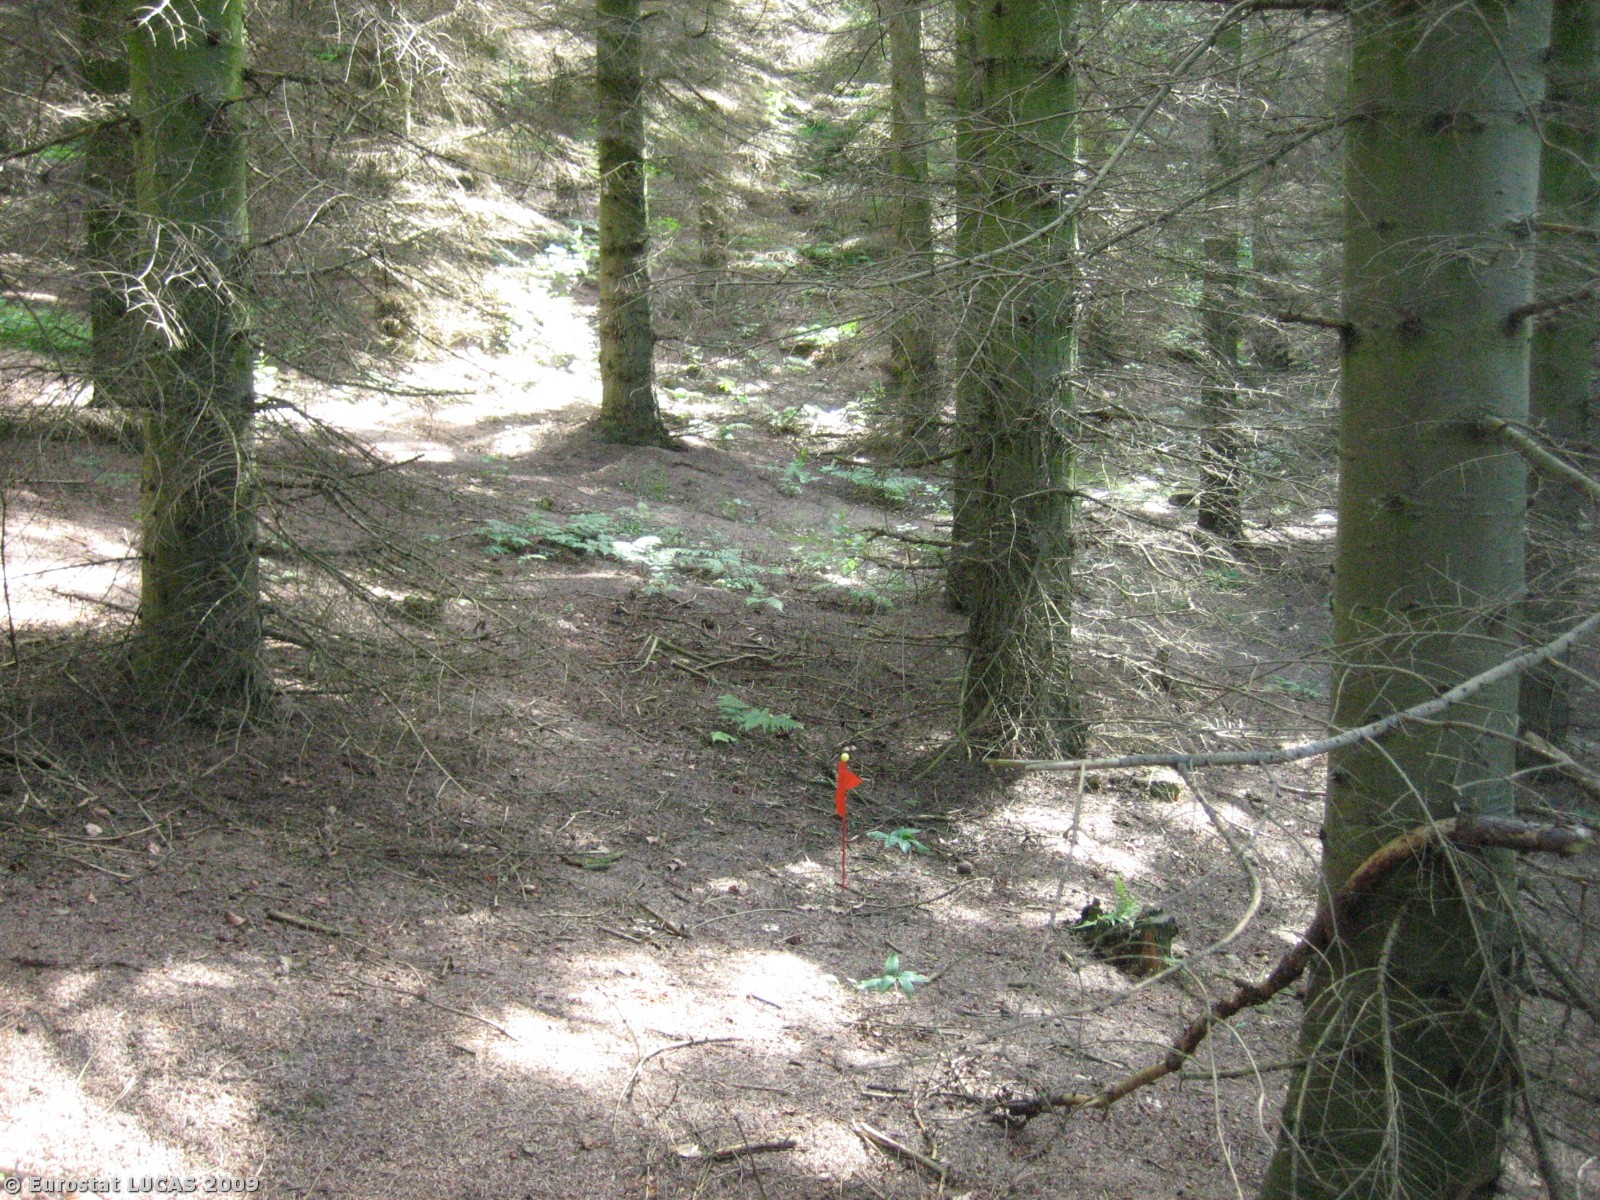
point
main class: Woodland
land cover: Coniferous woodland
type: hemiboreal forest and nemoral coniferous forest and mixed broadleaved-coniferous forest
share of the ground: > 75 %
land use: Forestry
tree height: > 5 m
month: June
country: DK
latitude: 55.7922
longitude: 9.8566
